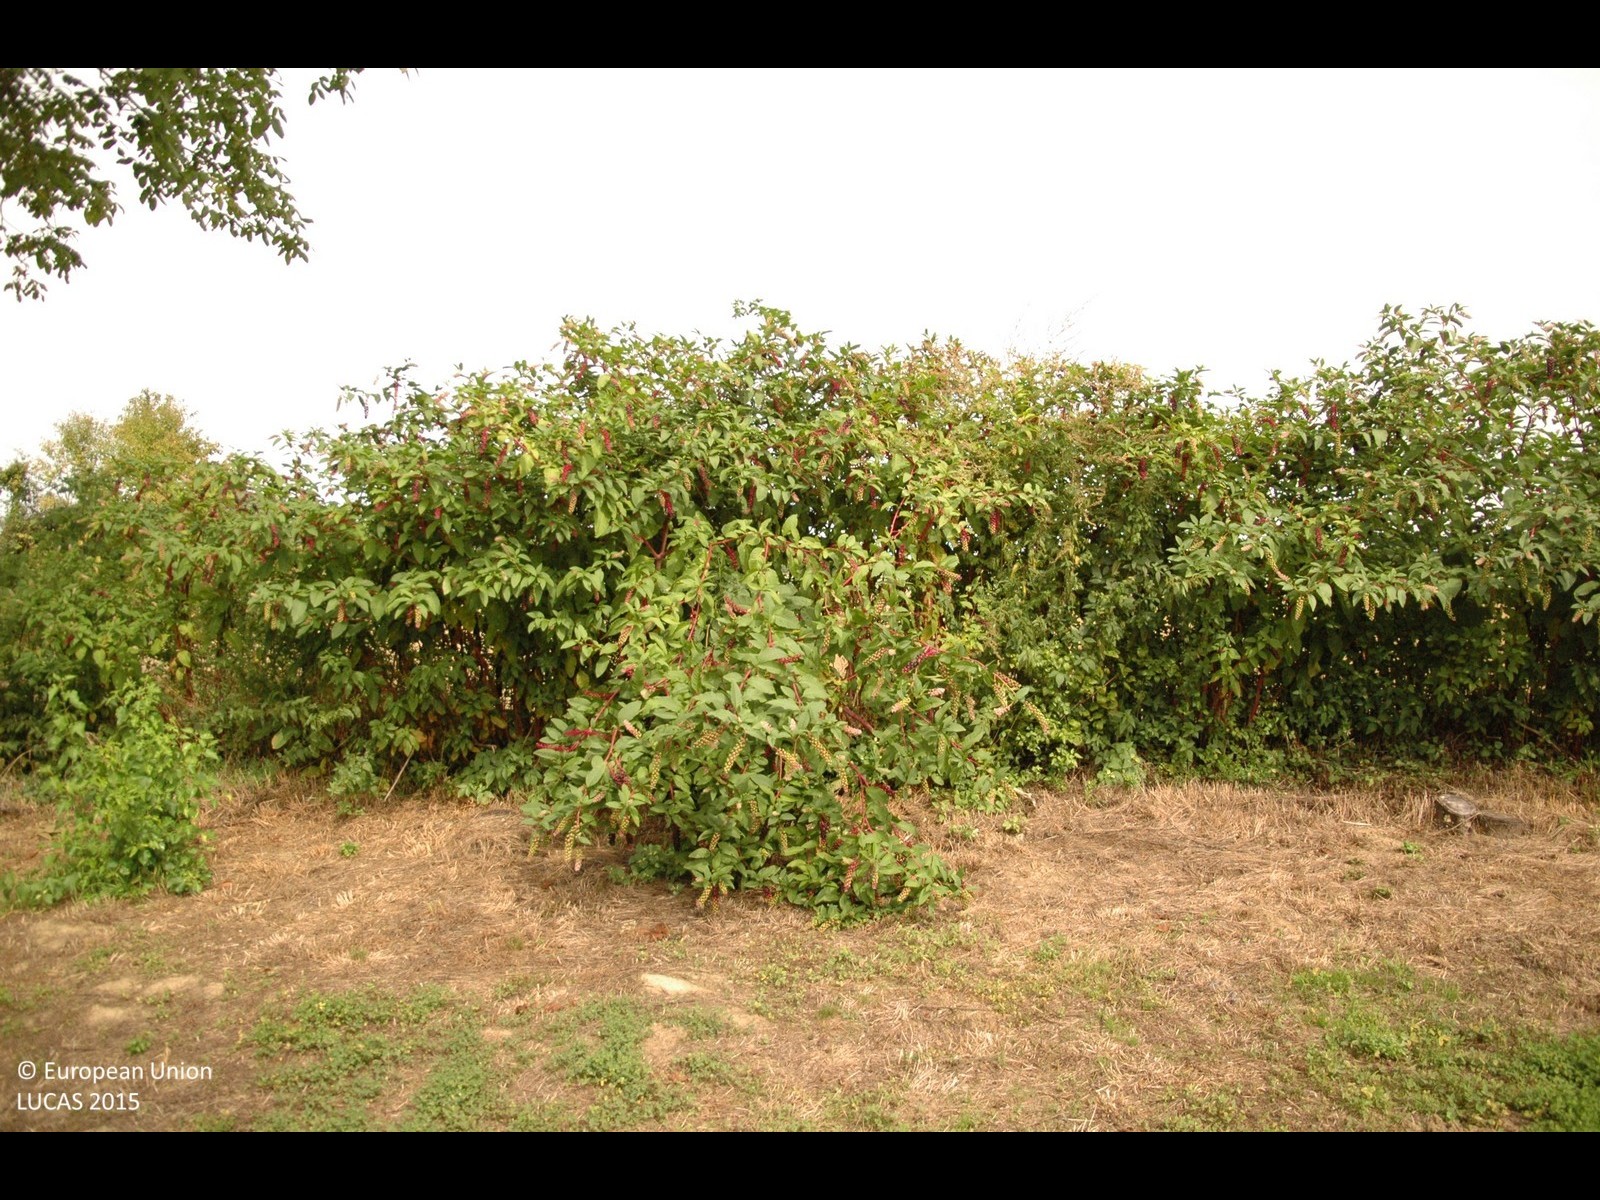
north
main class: Grassland
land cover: Grassland with sparse tree/shrub cover
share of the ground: > 75 %
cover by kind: herbaceous plants 95 %, broadleaved forest trees 5 %
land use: Agriculture (excluding fallow land and kitchen gardens)
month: September
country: HR
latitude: 46.0729
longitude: 16.9185
